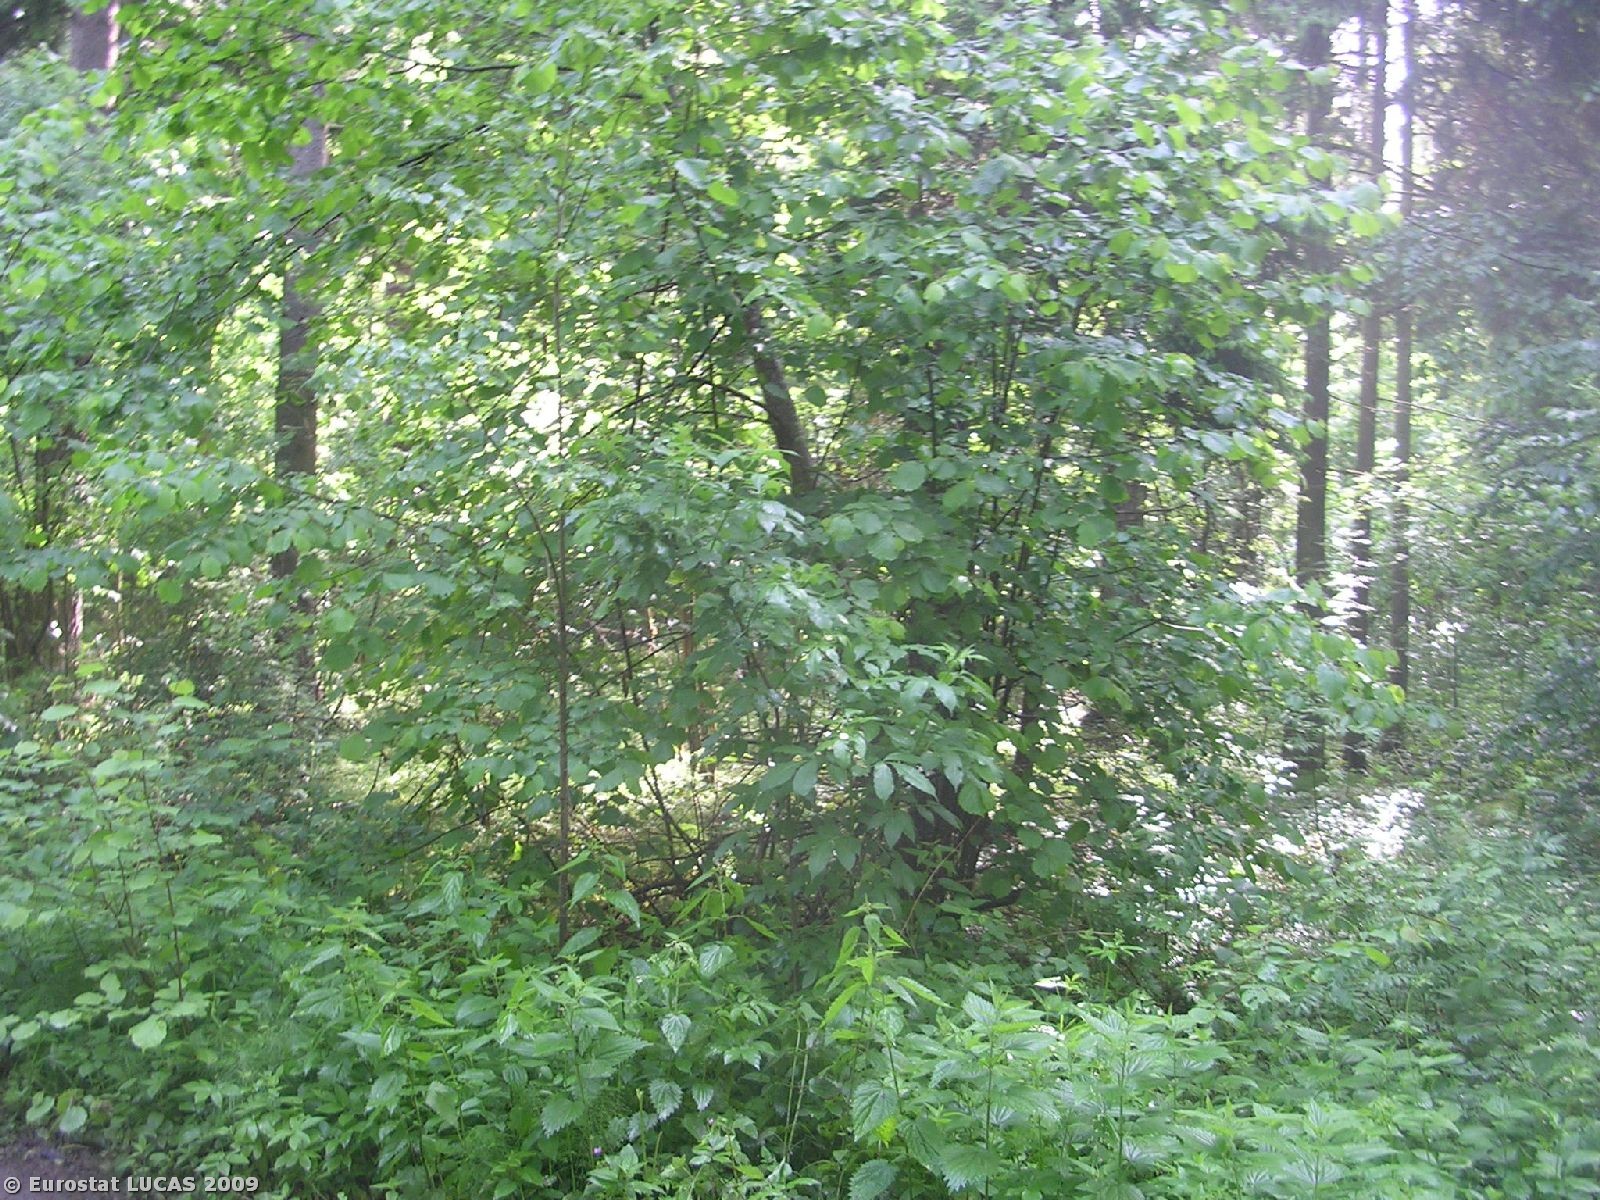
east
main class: Woodland
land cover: Mixed woodland
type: hemiboreal forest and nemoral coniferous forest and mixed broadleaved-coniferous forest
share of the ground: 50 - 75 %
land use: Forestry
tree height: > 5 m
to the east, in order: Mixed woodland; Grassland without tree/shrub cover; Grassland with sparse tree/shrub cover
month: June
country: PL
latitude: 53.4289
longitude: 23.3092
